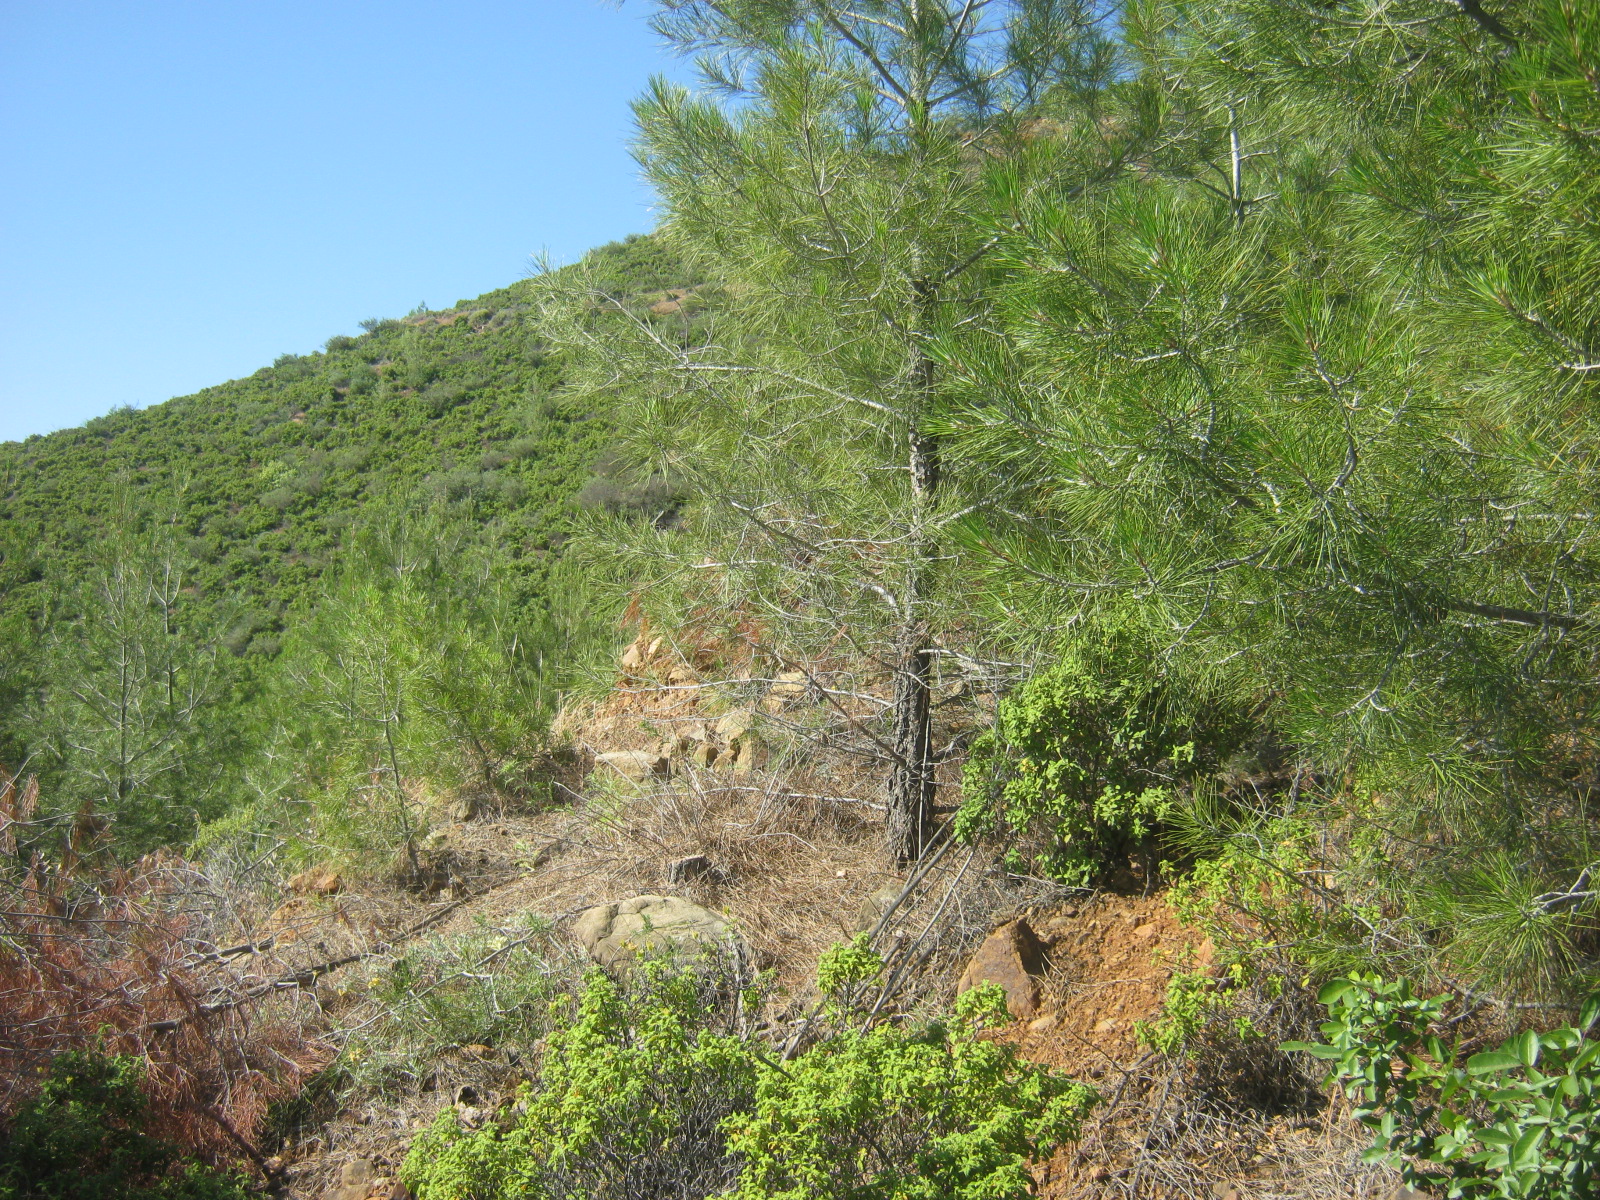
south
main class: Woodland
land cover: Pine dominated coniferous woodland
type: coniferous forest of the mediterranean region
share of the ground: 25 - 50 %
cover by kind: coniferous forest trees 40 %, shrubs 25 %, herbaceous plants 20 %, unconsolidated bare surface 15 %
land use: Forestry
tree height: < 5 m
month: May
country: CY
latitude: 35.0612
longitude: 32.8340
